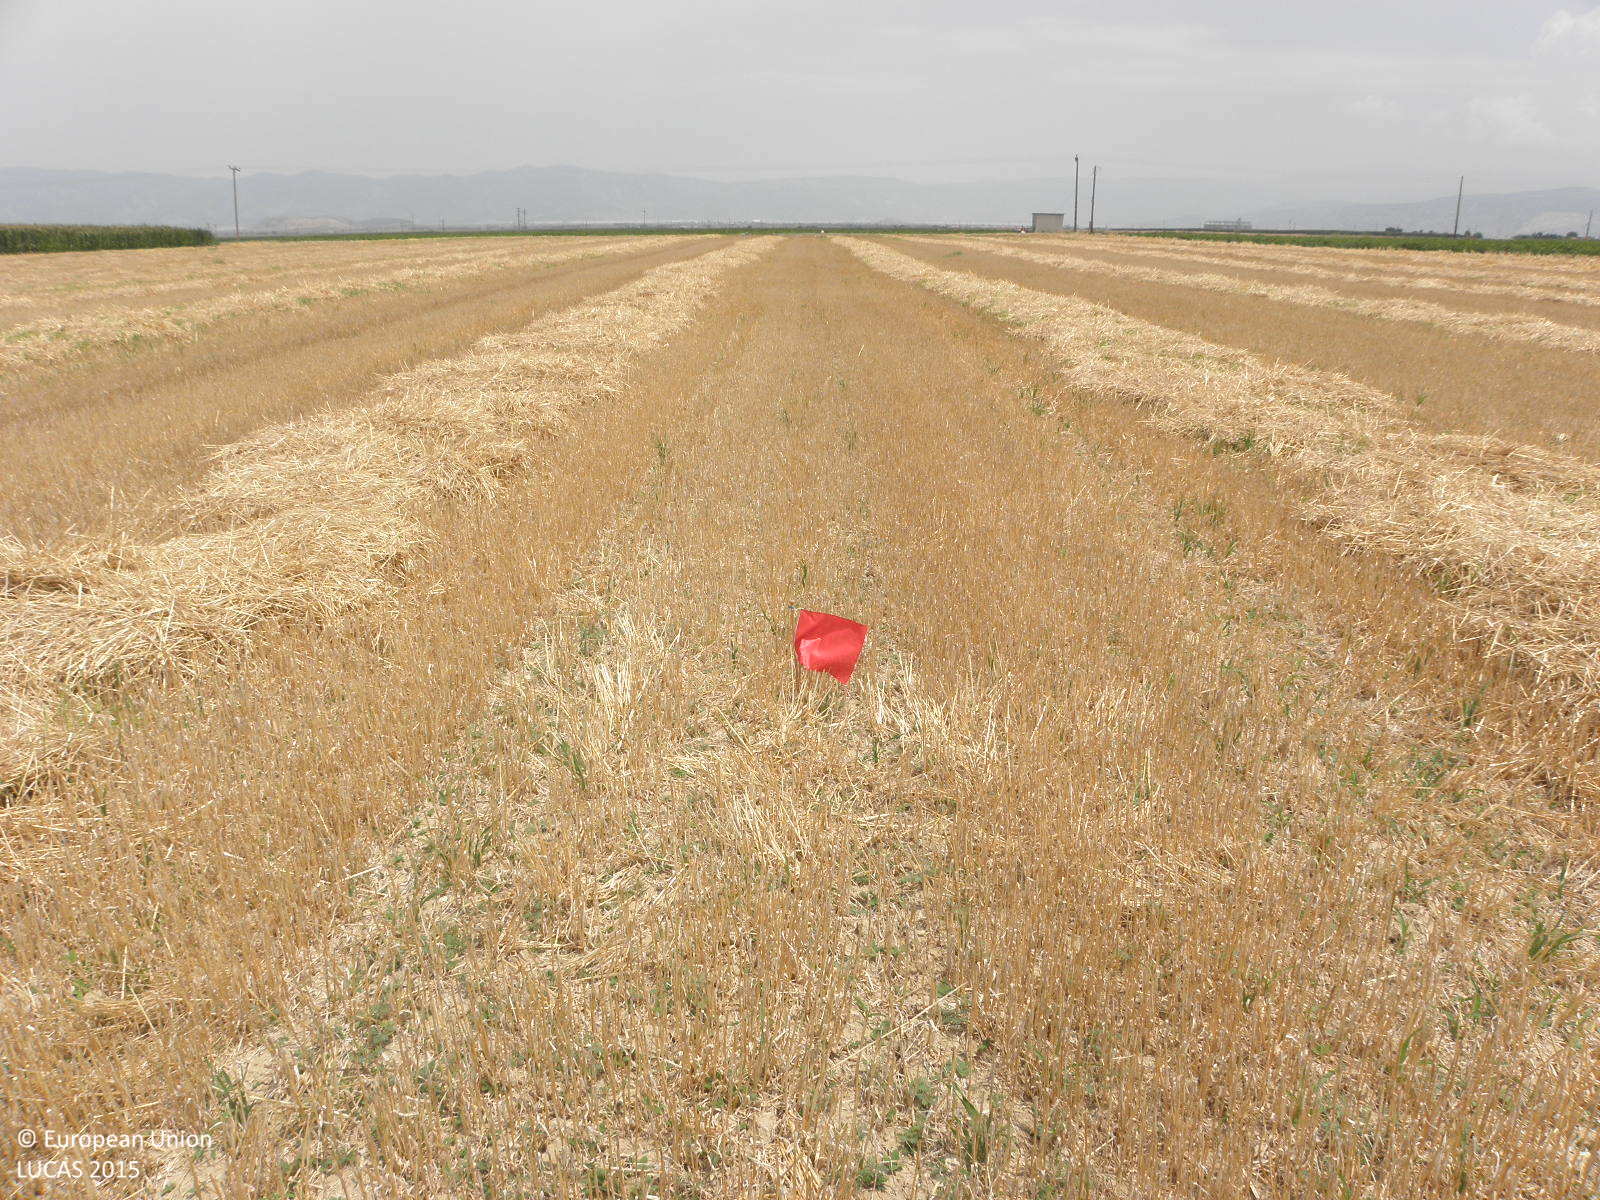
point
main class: Cropland
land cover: Durum wheat
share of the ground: > 75 %
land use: Agriculture (excluding fallow land and kitchen gardens)
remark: Harvested field
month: July
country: GR
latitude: 39.4576
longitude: 22.6929
